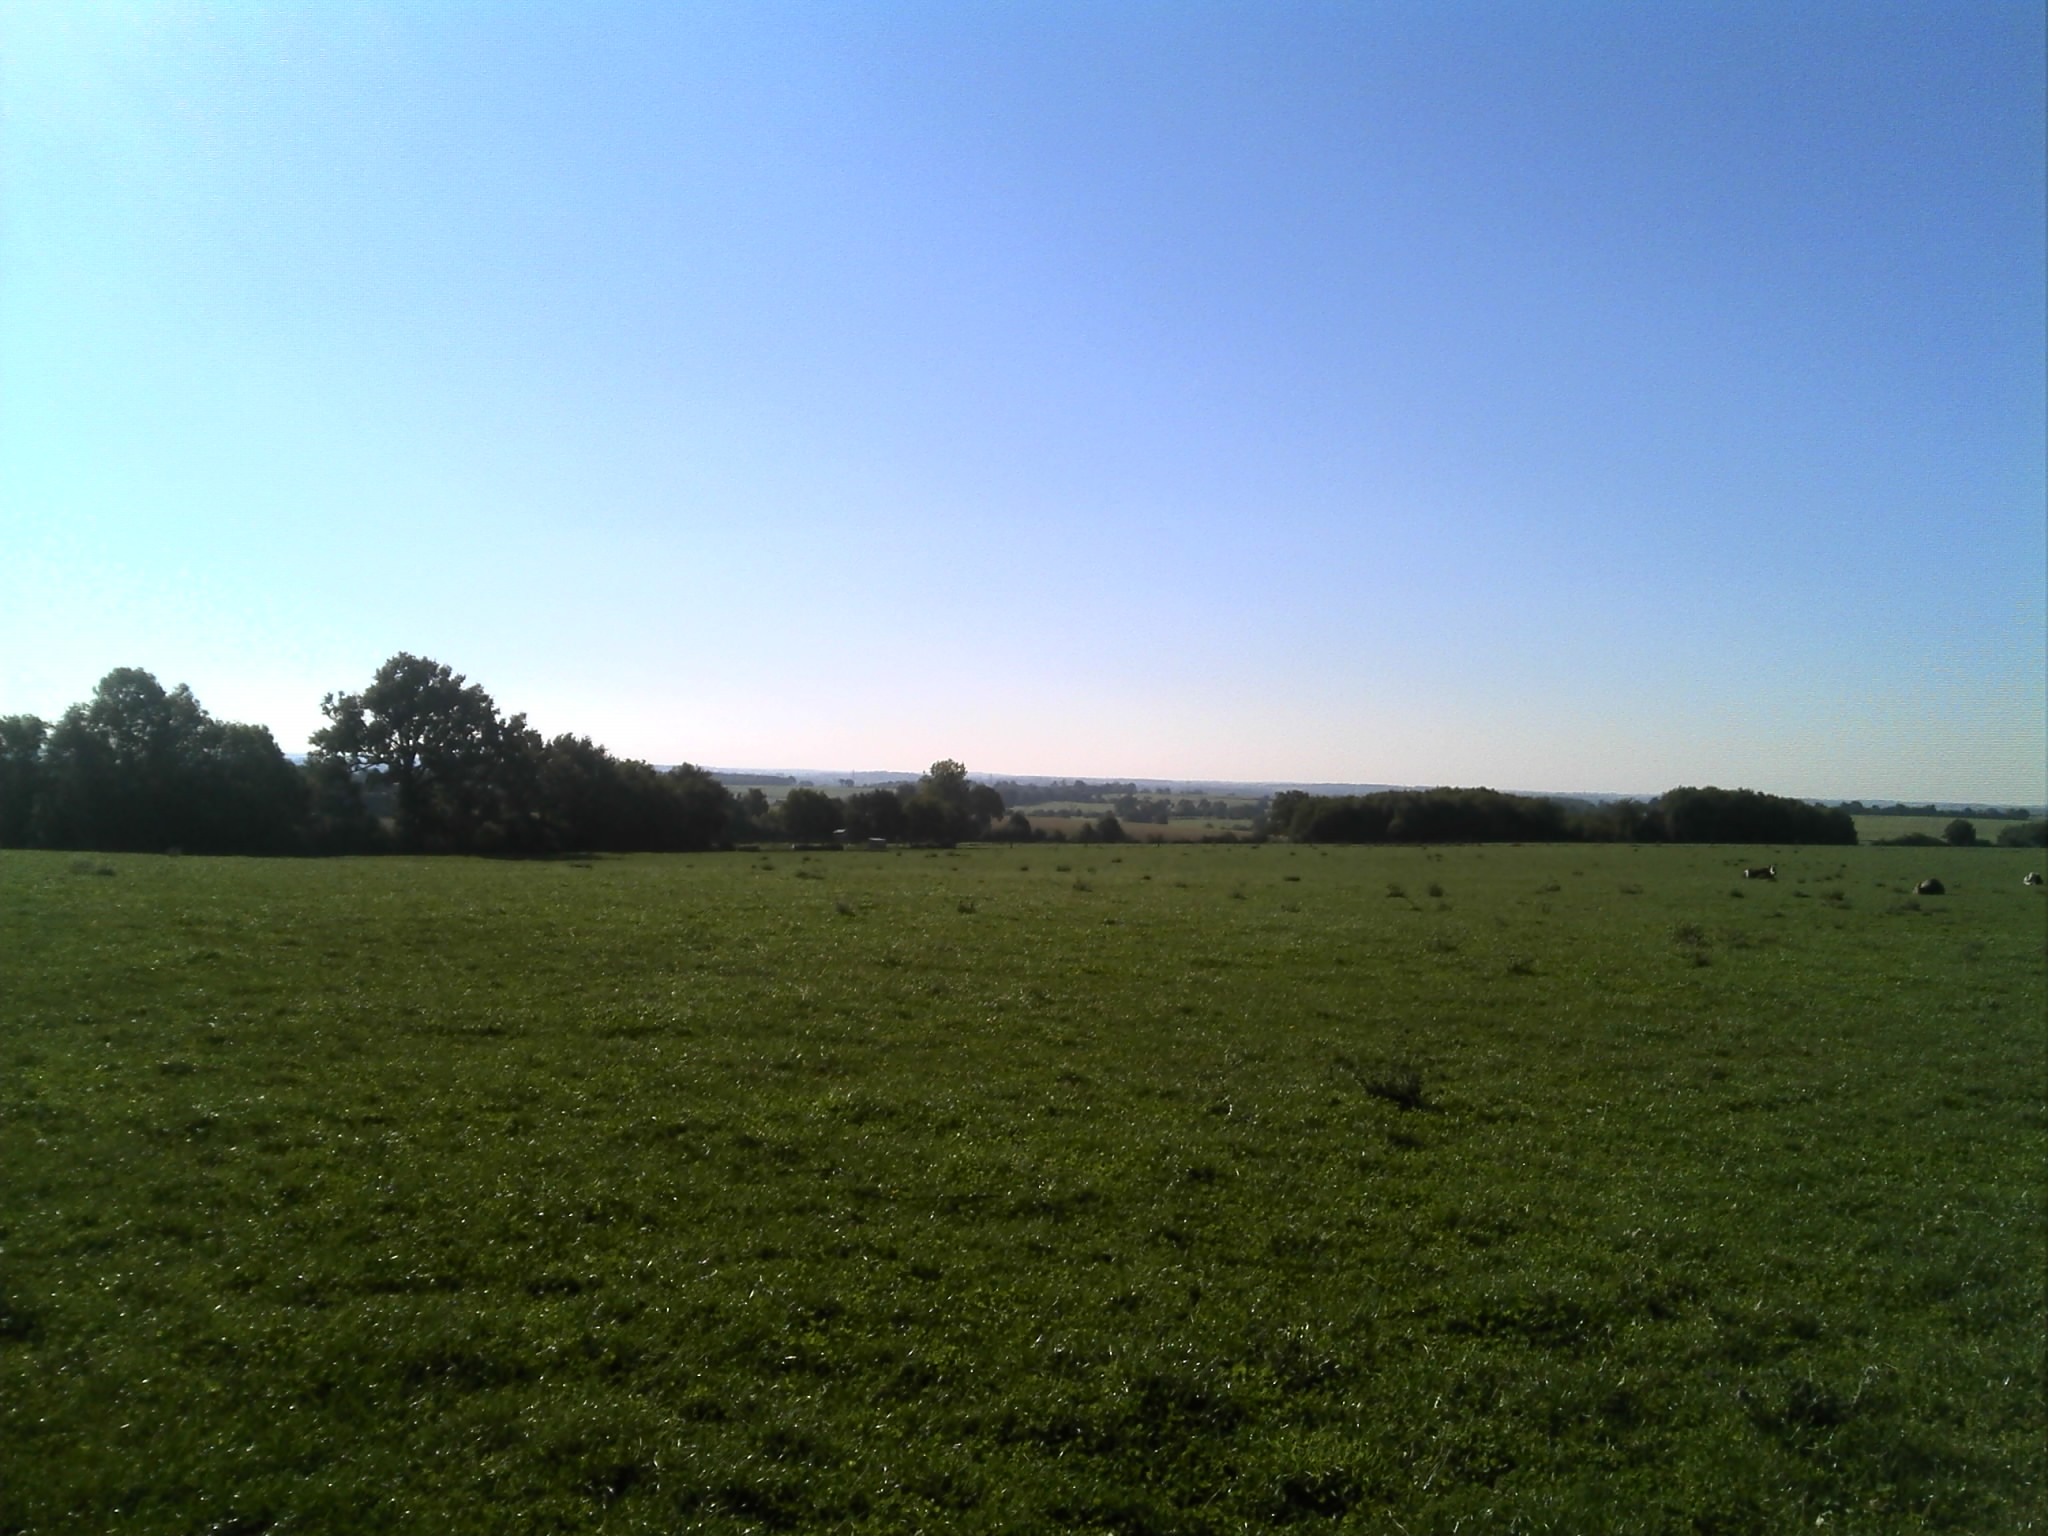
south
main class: Grassland
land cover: Grassland without tree/shrub cover
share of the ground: > 75 %
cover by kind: herbaceous plants 100 %
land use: Agriculture (excluding fallow land and kitchen gardens)
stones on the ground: < 10 %
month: October
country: FR
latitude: 47.6128
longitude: -1.0397
